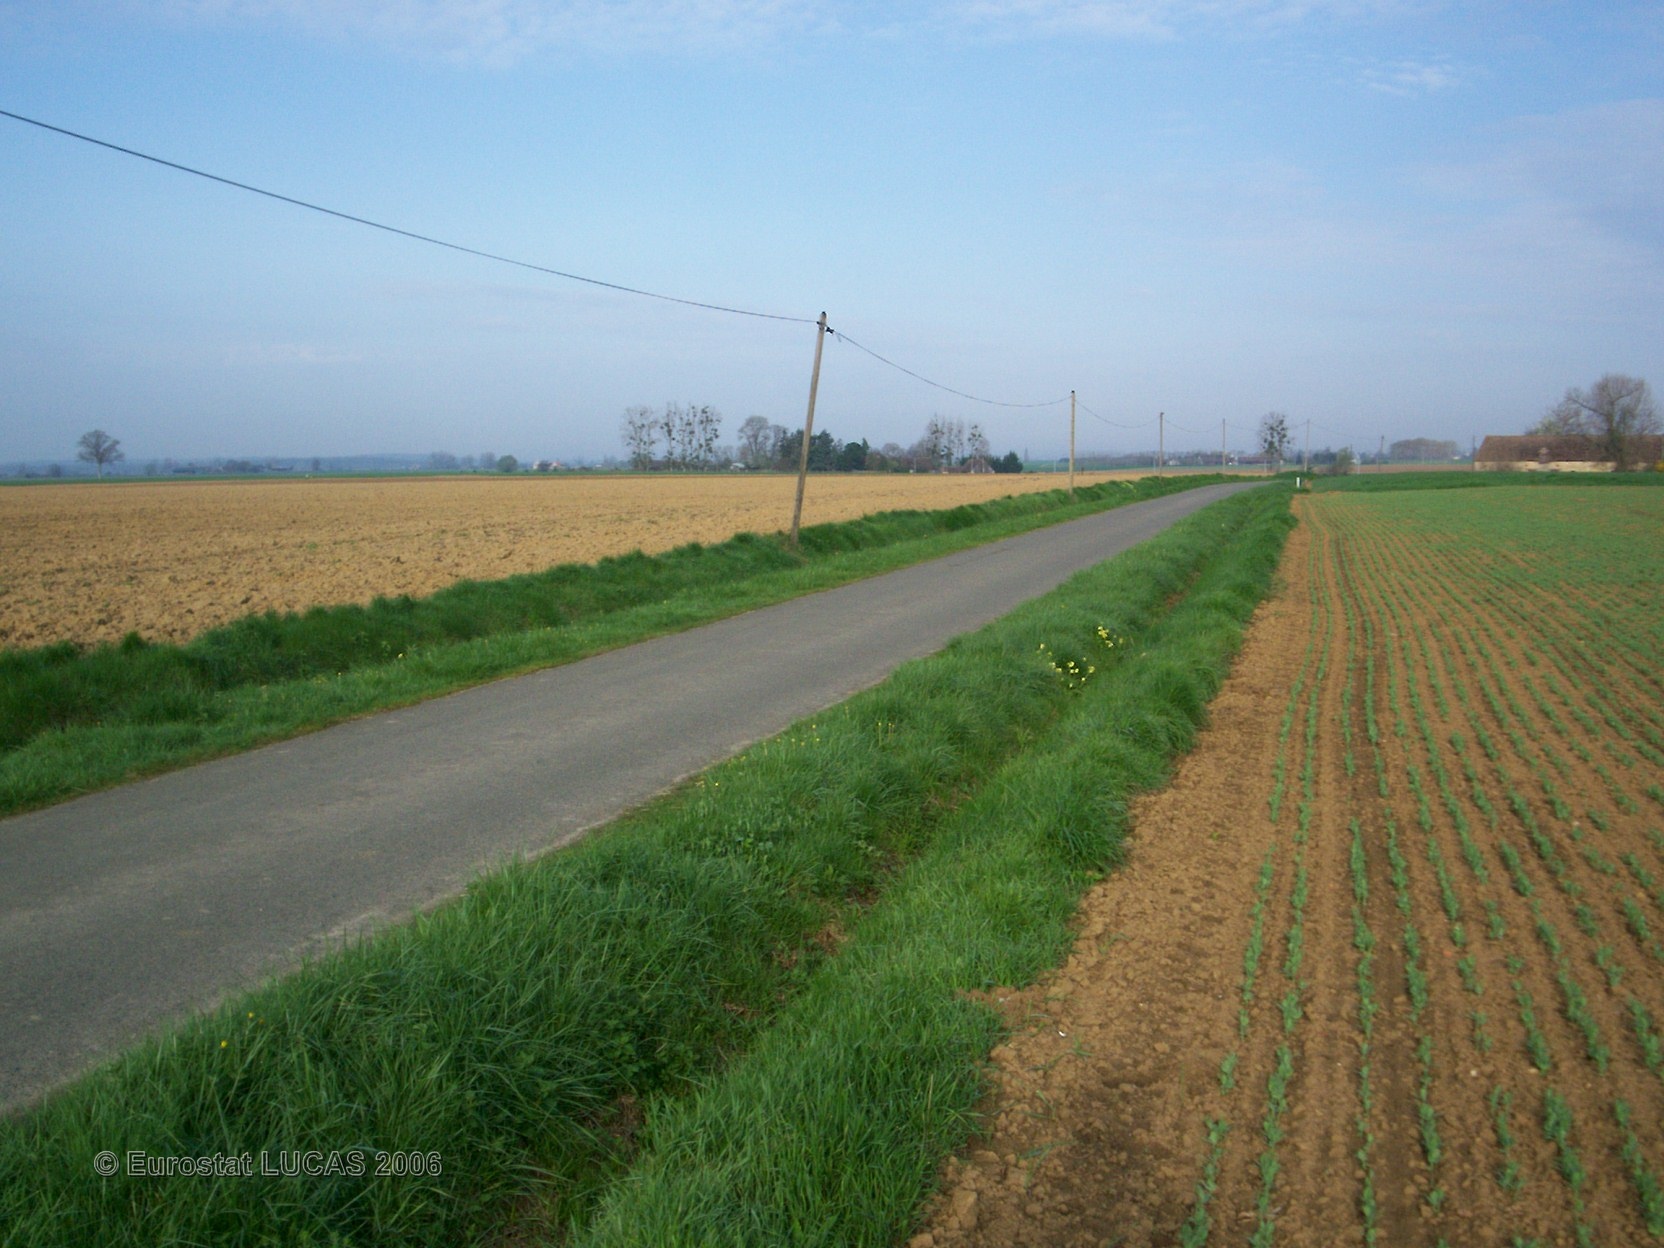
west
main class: Cropland
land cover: Dry pulses
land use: Agriculture (excluding fallow land and kitchen gardens)
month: April
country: FR
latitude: 48.2246
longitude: 0.2413
